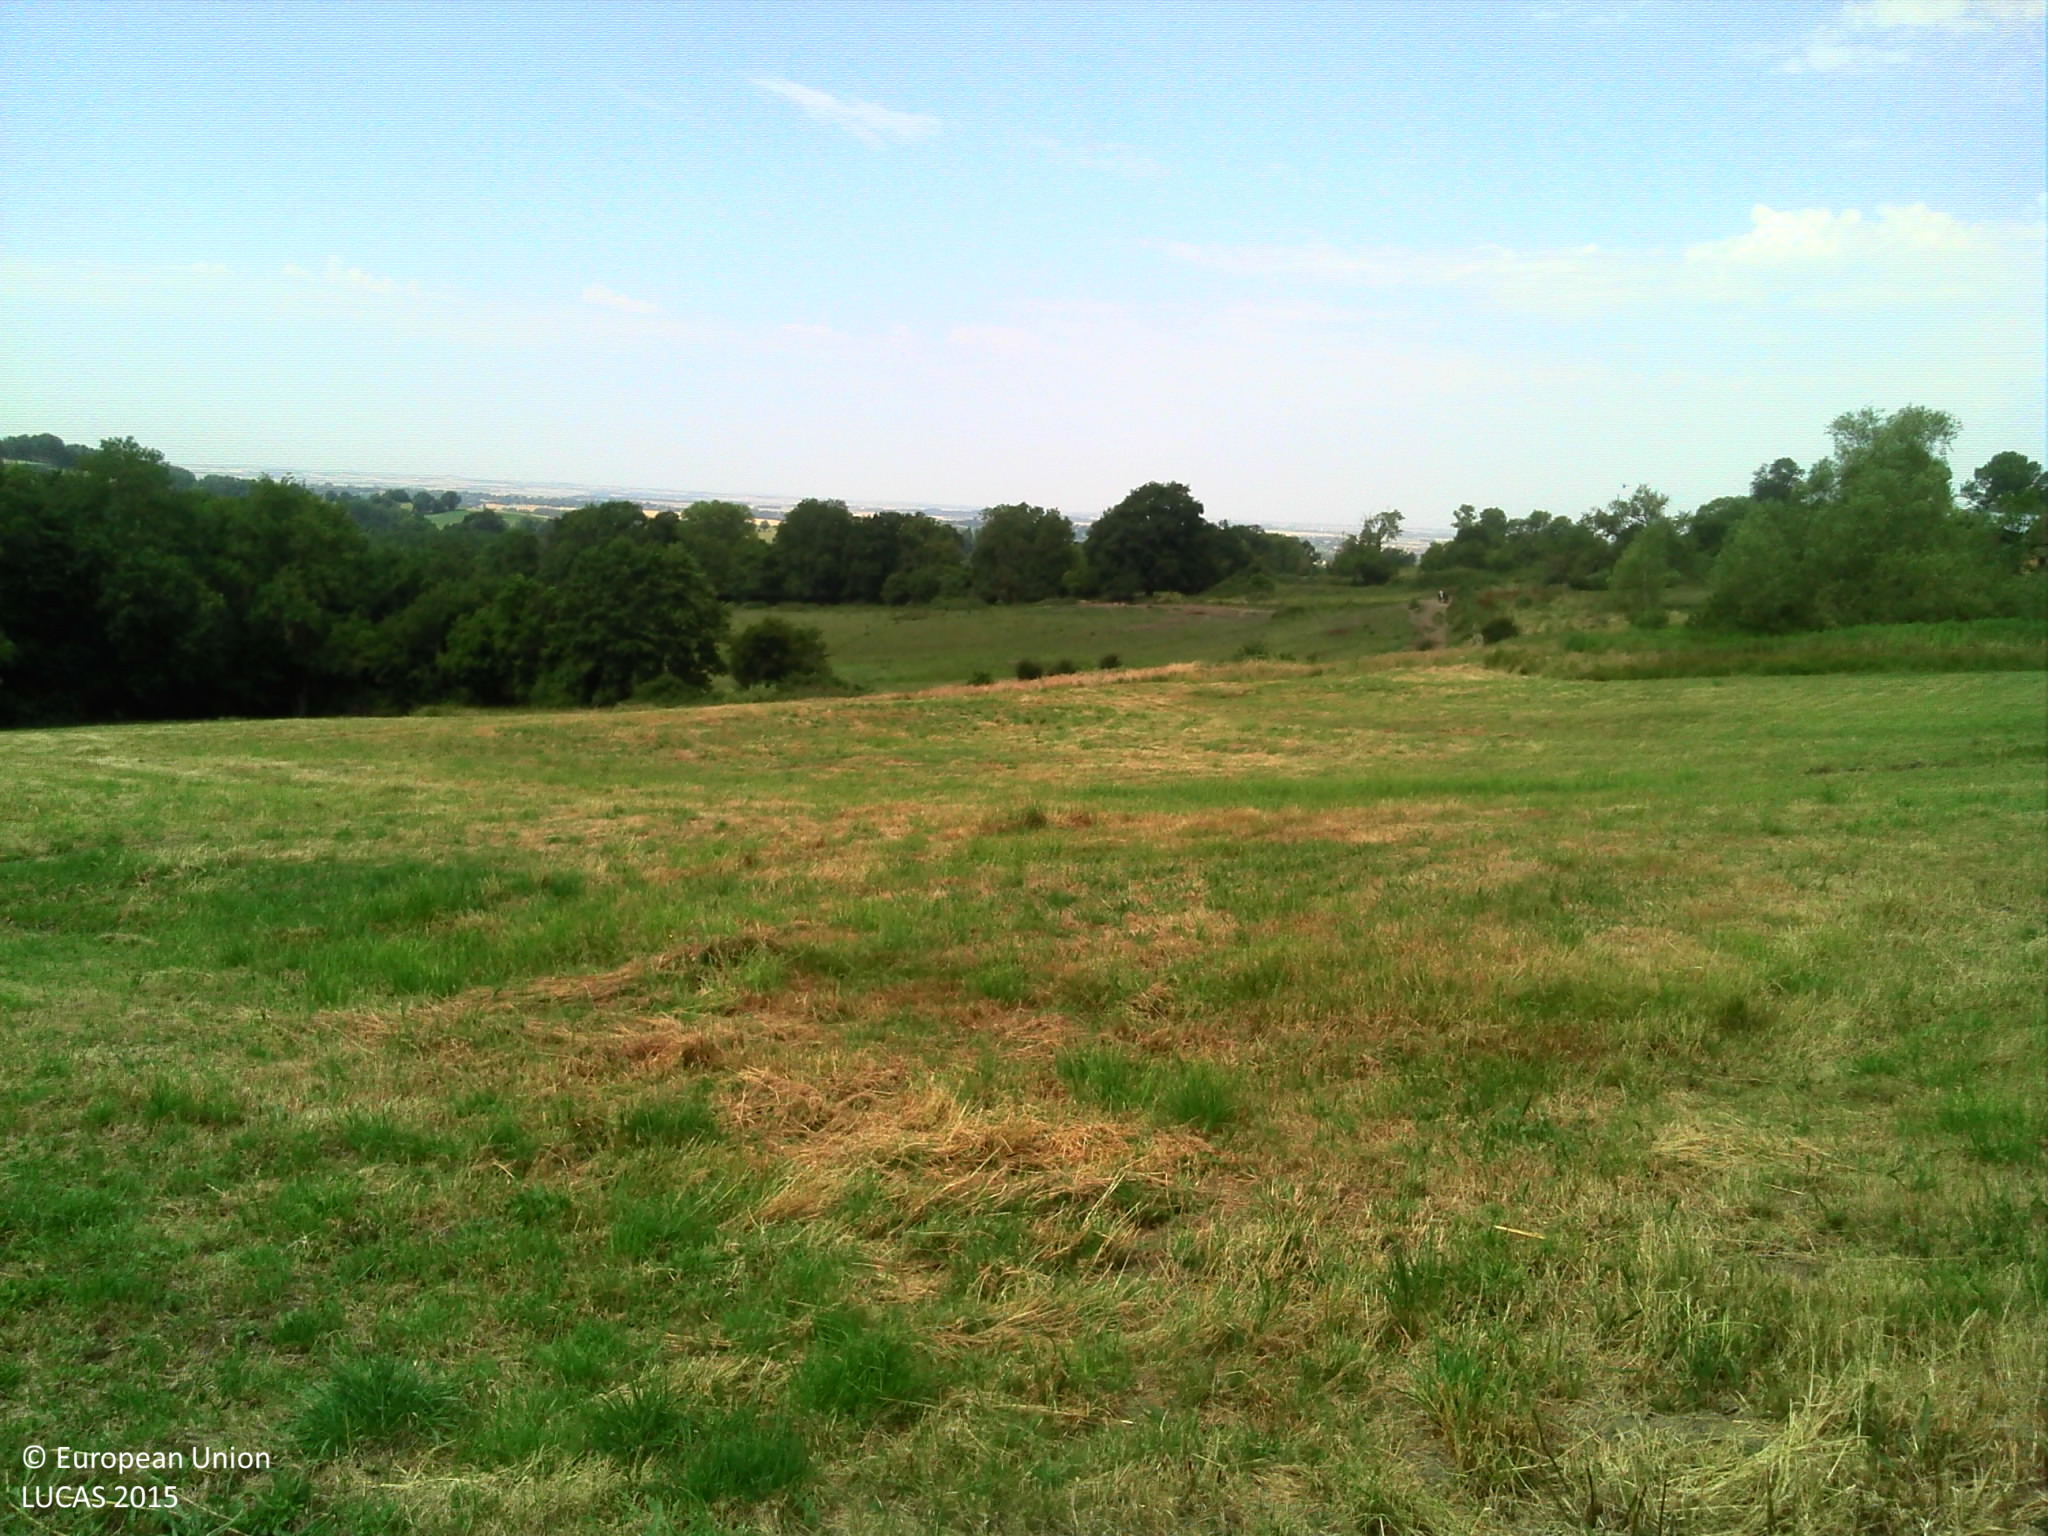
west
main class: Grassland
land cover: Grassland without tree/shrub cover
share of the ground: > 75 %
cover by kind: herbaceous plants 100 %
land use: Agriculture (excluding fallow land and kitchen gardens)
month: July
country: FR
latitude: 49.0259
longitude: 0.0823
